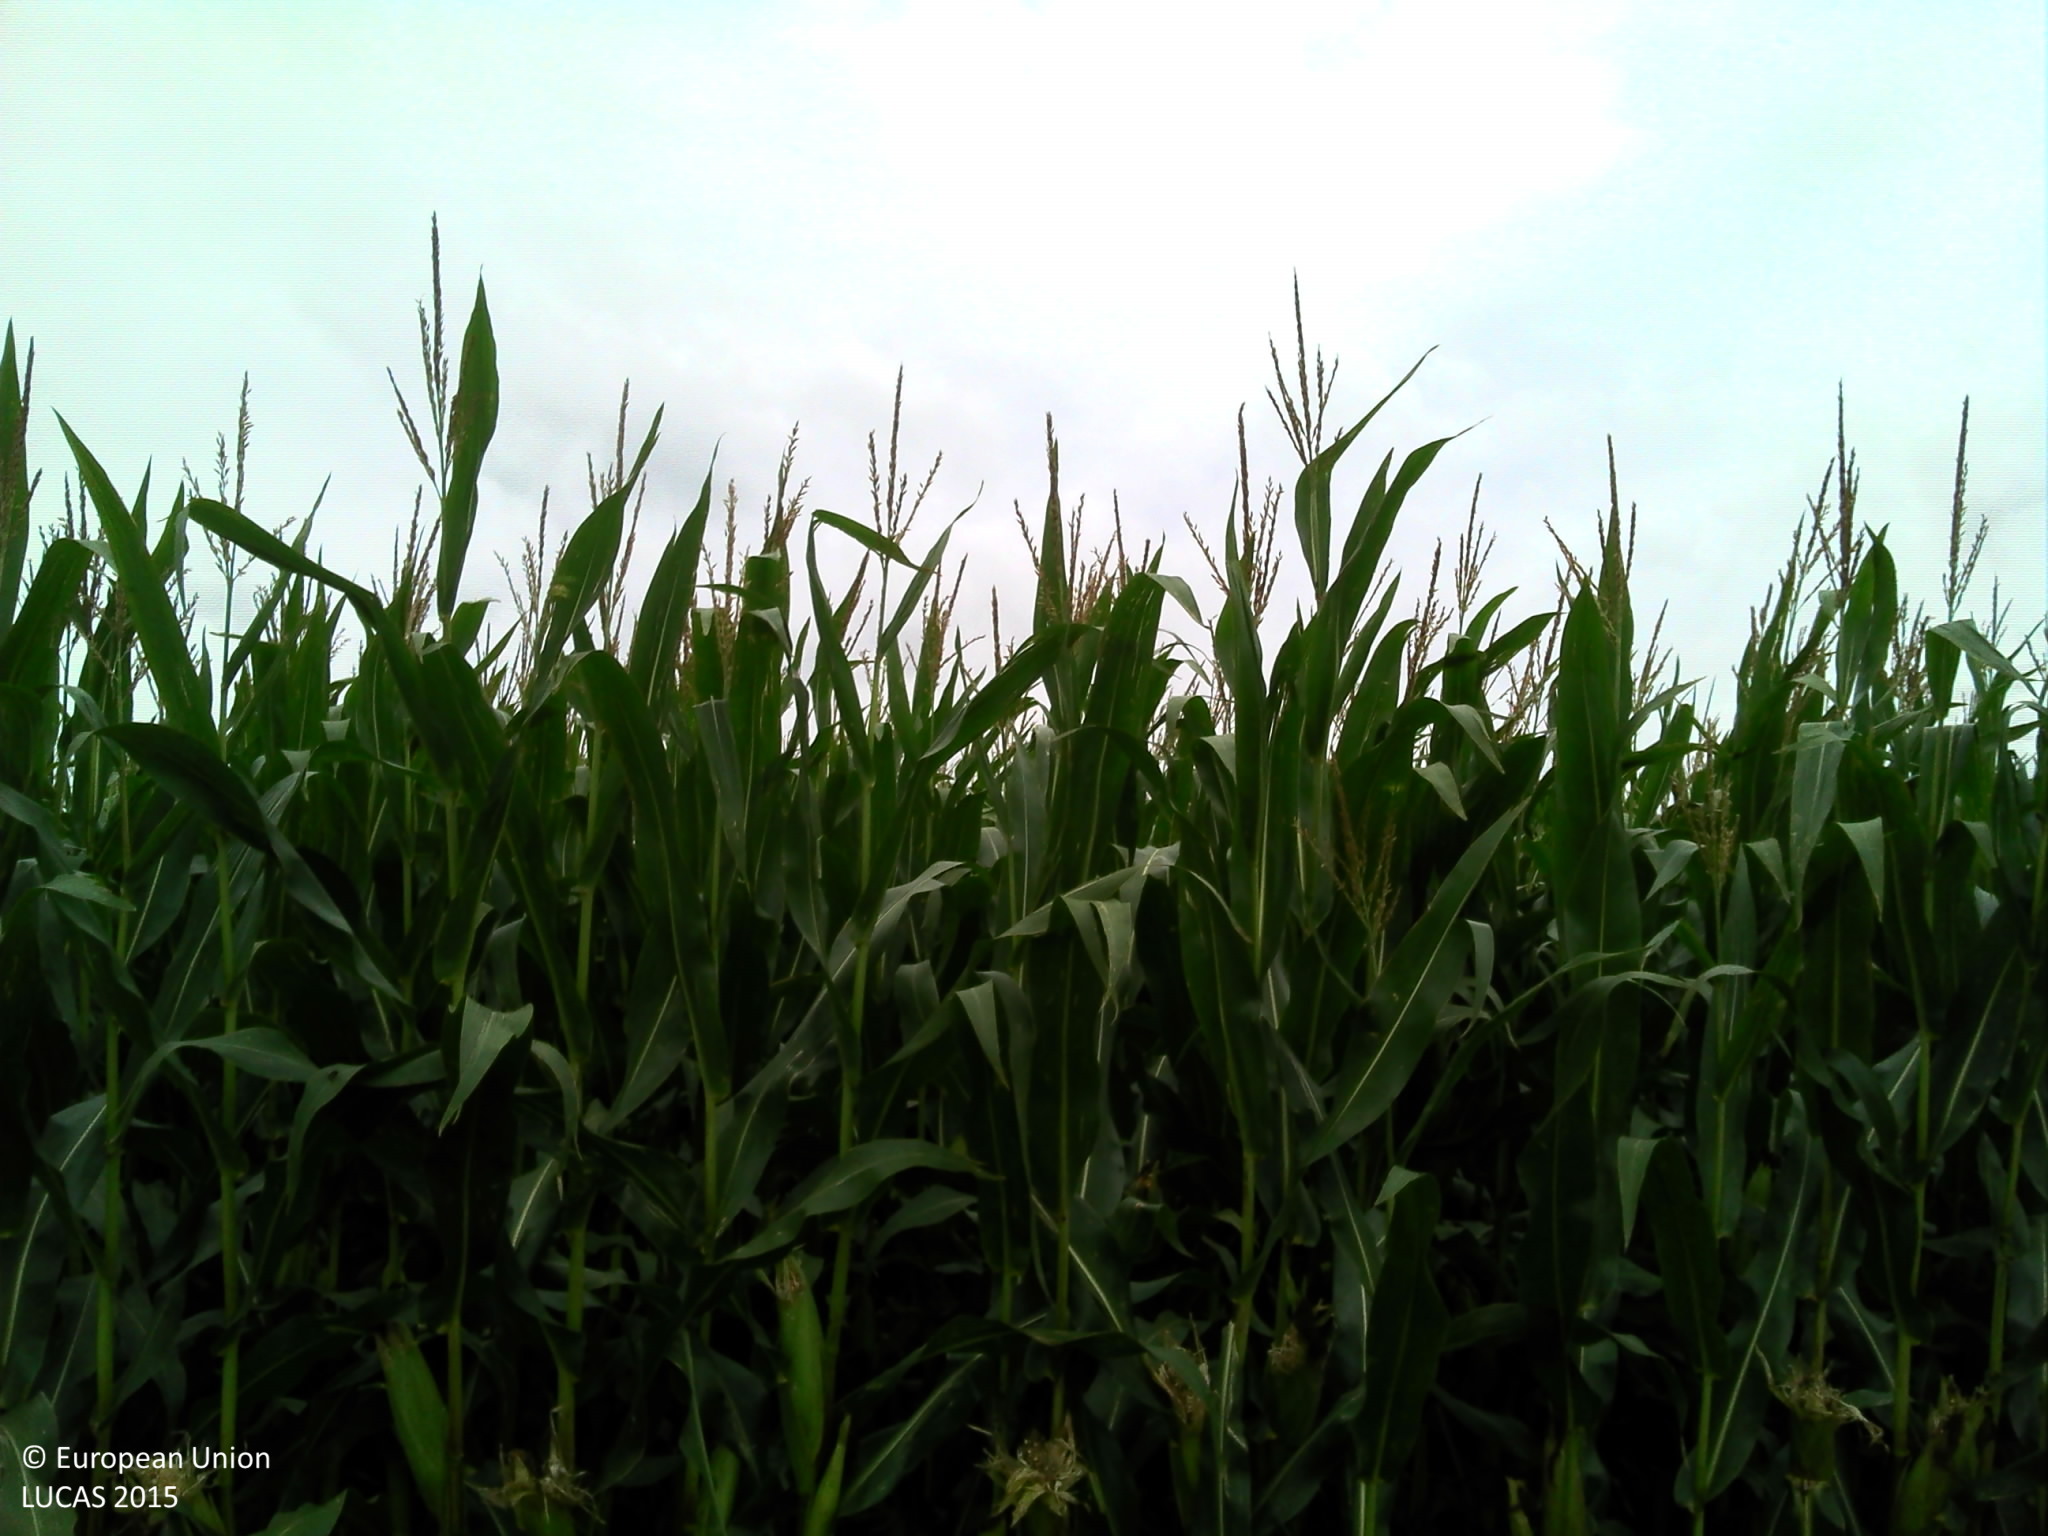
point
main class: Cropland
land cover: Maize
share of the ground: > 75 %
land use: Agriculture (excluding fallow land and kitchen gardens)
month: September
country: BE
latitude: 51.1294
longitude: 3.0884
